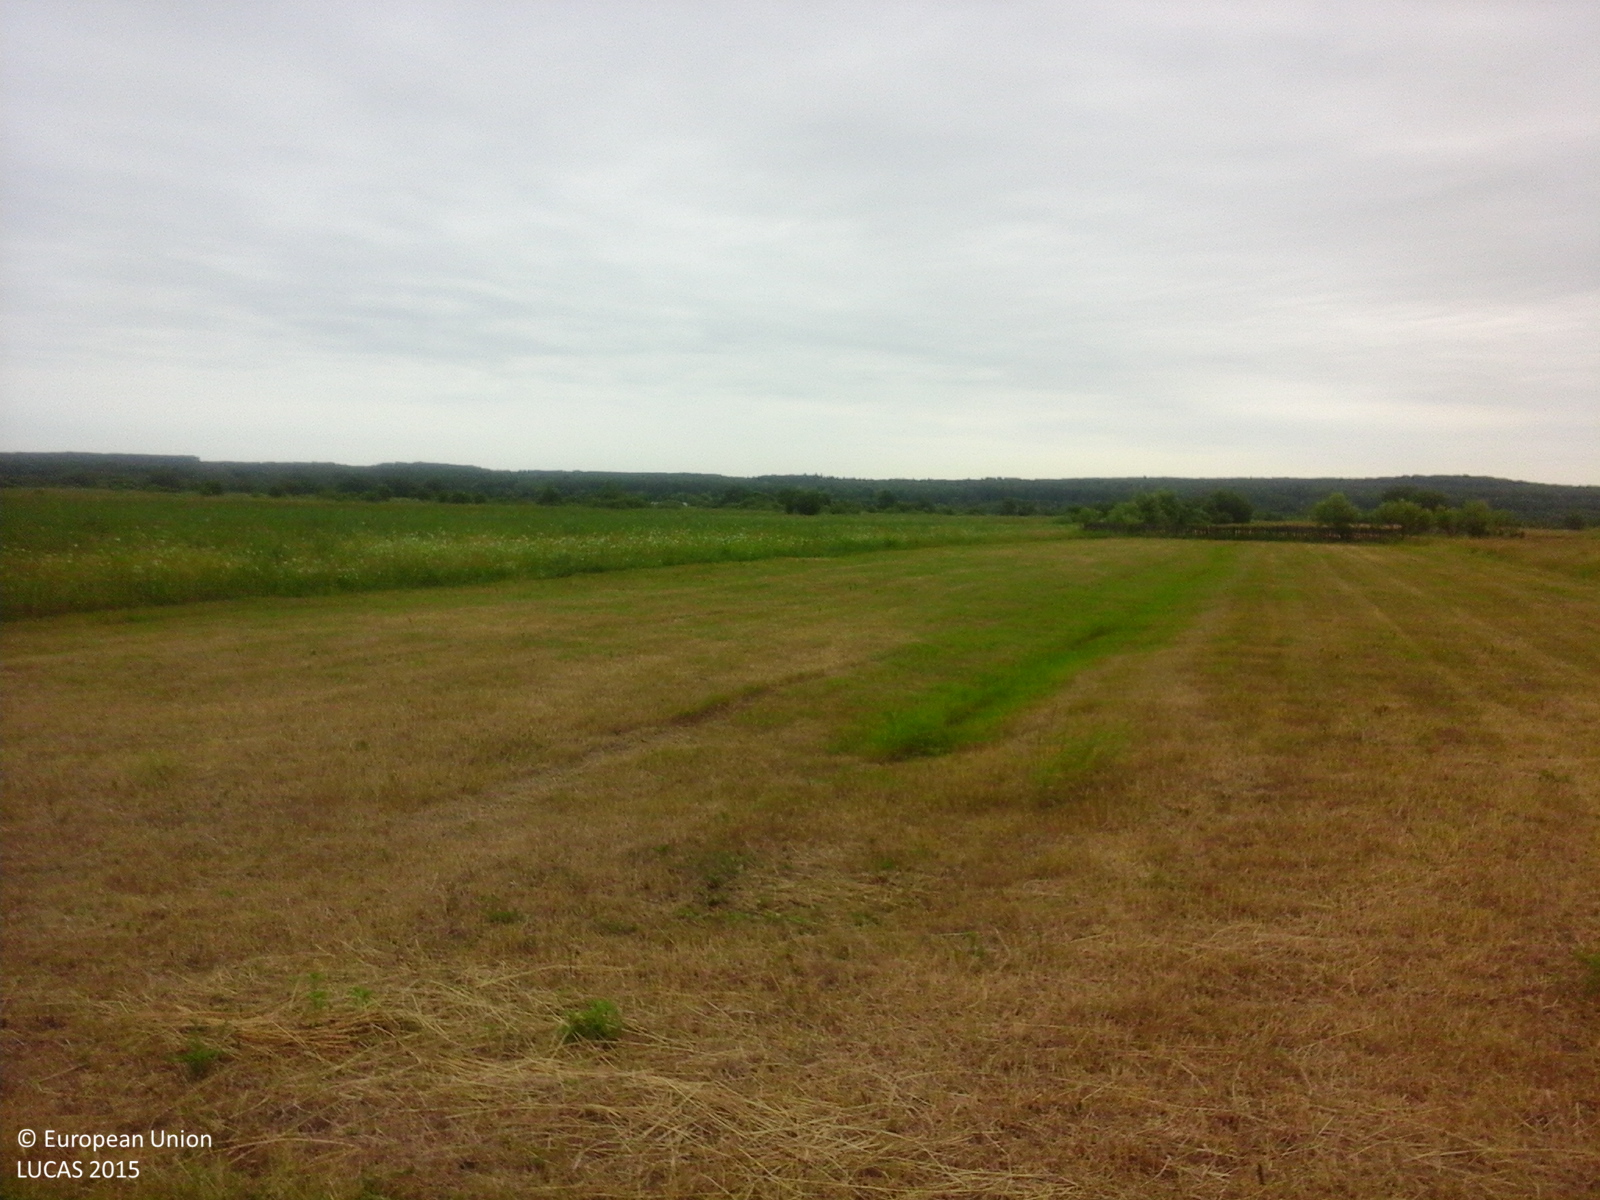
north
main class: Grassland
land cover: Grassland without tree/shrub cover
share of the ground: > 75 %
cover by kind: herbaceous plants 100 %
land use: Agriculture (excluding fallow land and kitchen gardens)
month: June
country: RO
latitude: 47.9300
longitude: 25.7174
